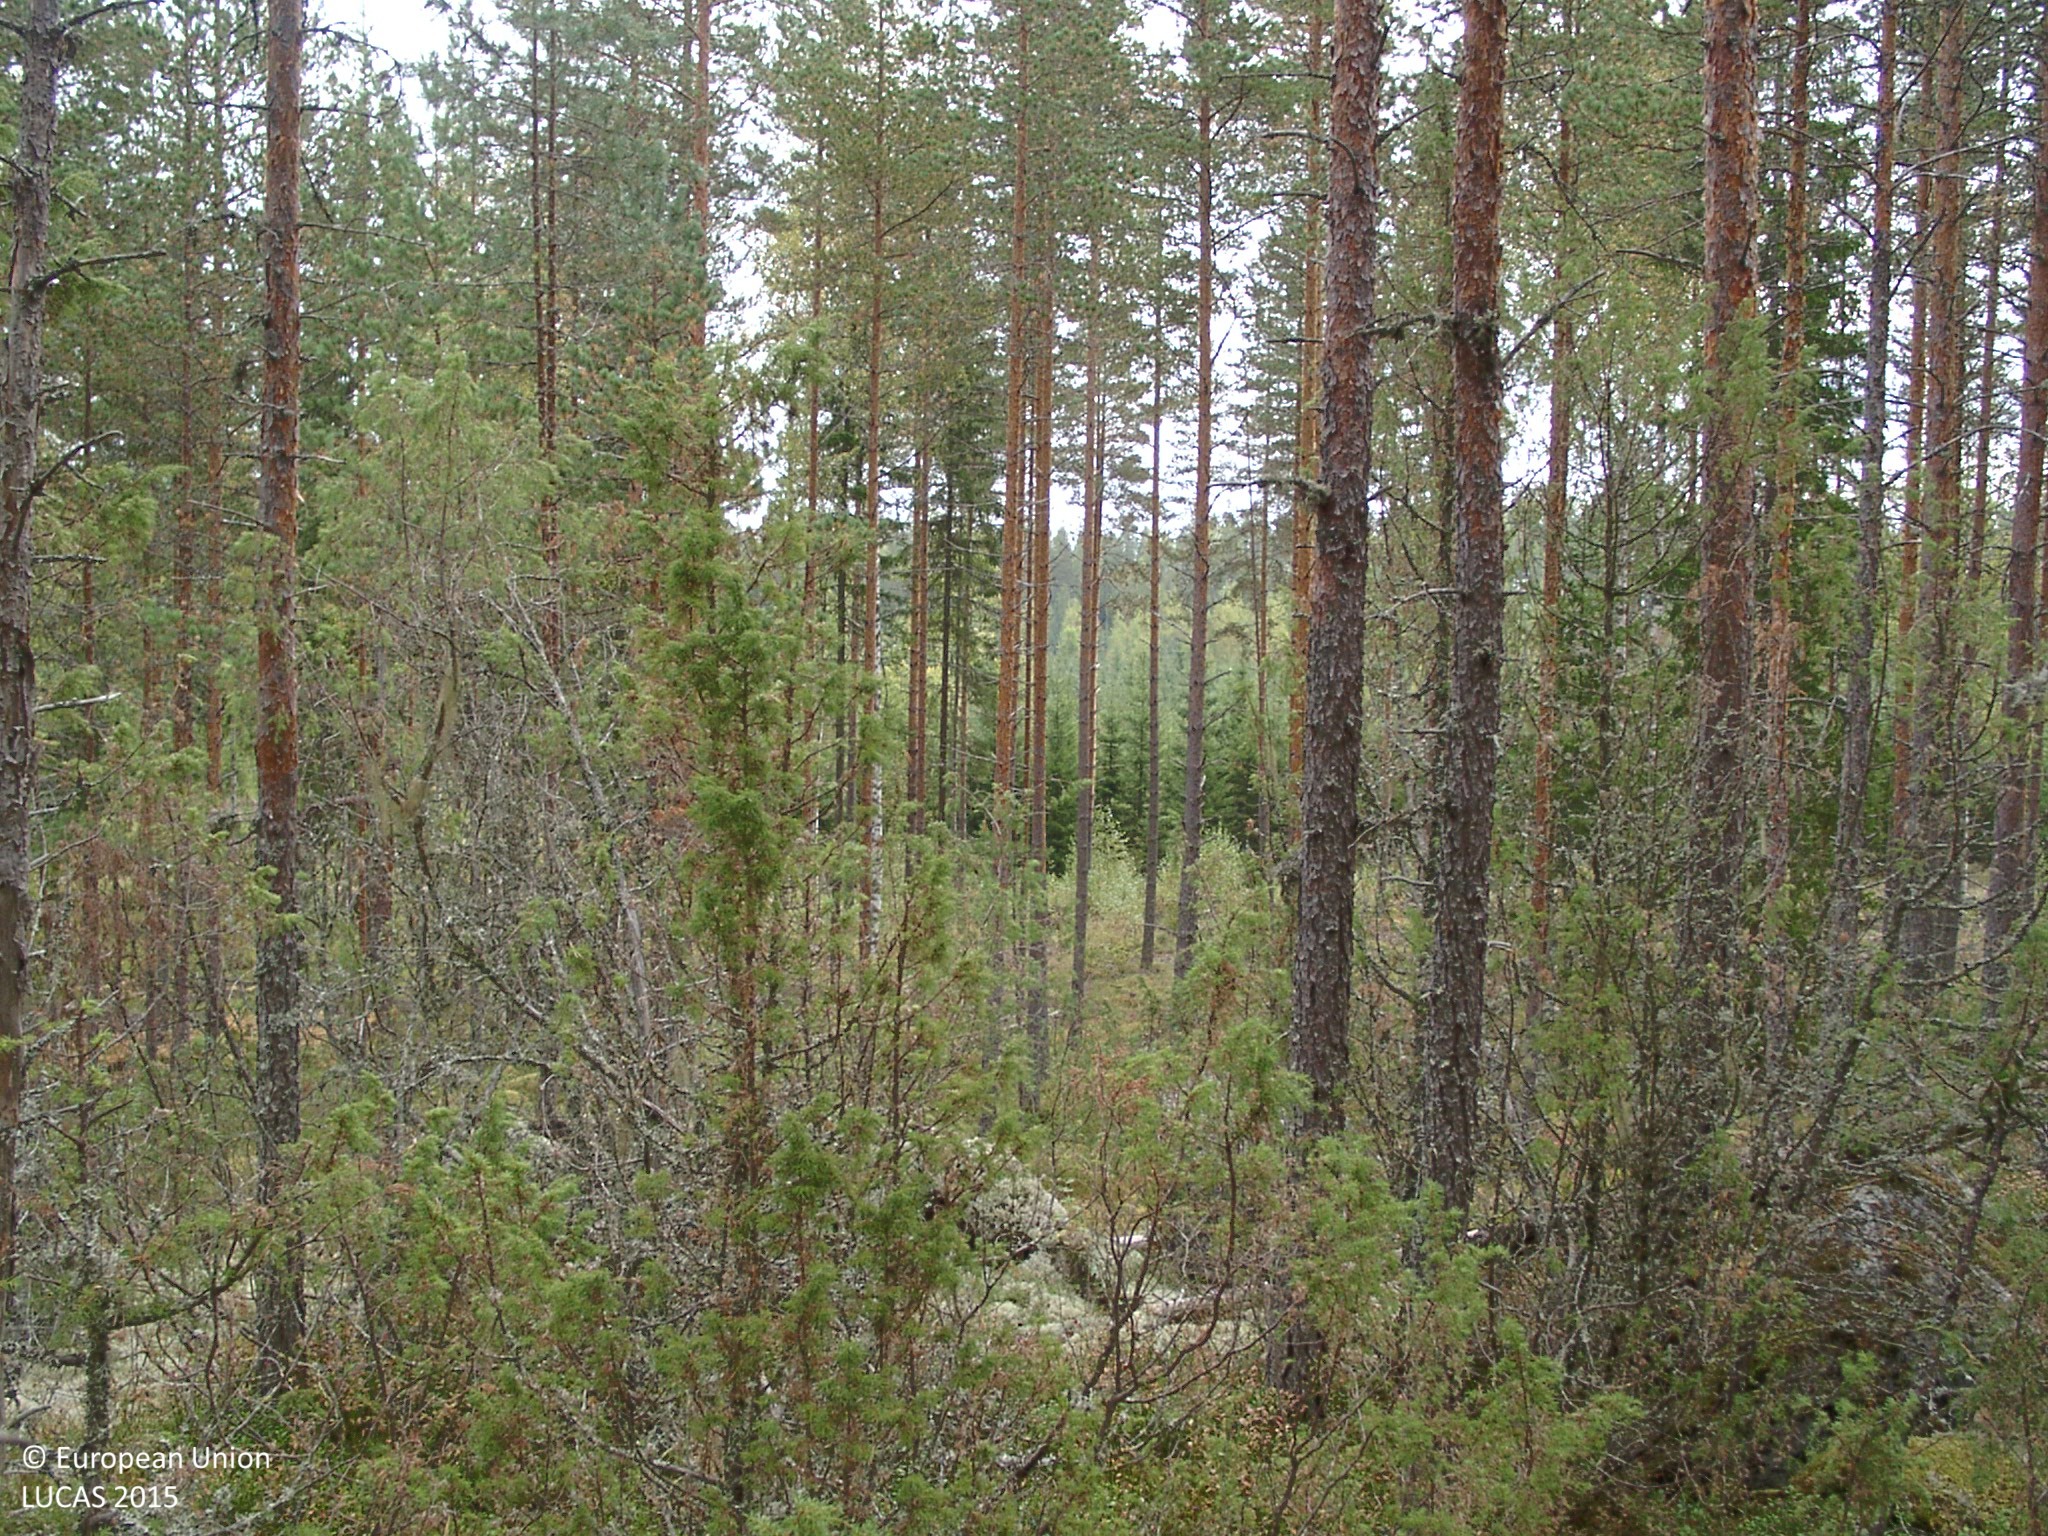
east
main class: Woodland
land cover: Pine dominated coniferous woodland
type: boreal forest
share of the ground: 25 - 50 %
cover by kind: lichens and mosses 45 %, shrubs 30 %, coniferous forest trees 25 %
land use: Forestry
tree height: > 5 m
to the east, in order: Pine dominated coniferous woodland; Pine dominated mixed woodland; Groves; Ditches and canals; Tracks; Ditches and canals; Shrubland with sparse tree cover; Ditches and canals; Spruce dominated coniferous woodland; Ditches and canals; Other coniferous woodland; Ditches and canals; Spruce dominated coniferous woodland; Other mixed woodland; Other coniferous woodland; Spruce dominated coniferous woodland
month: September
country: FI
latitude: 62.5312
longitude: 25.7612
